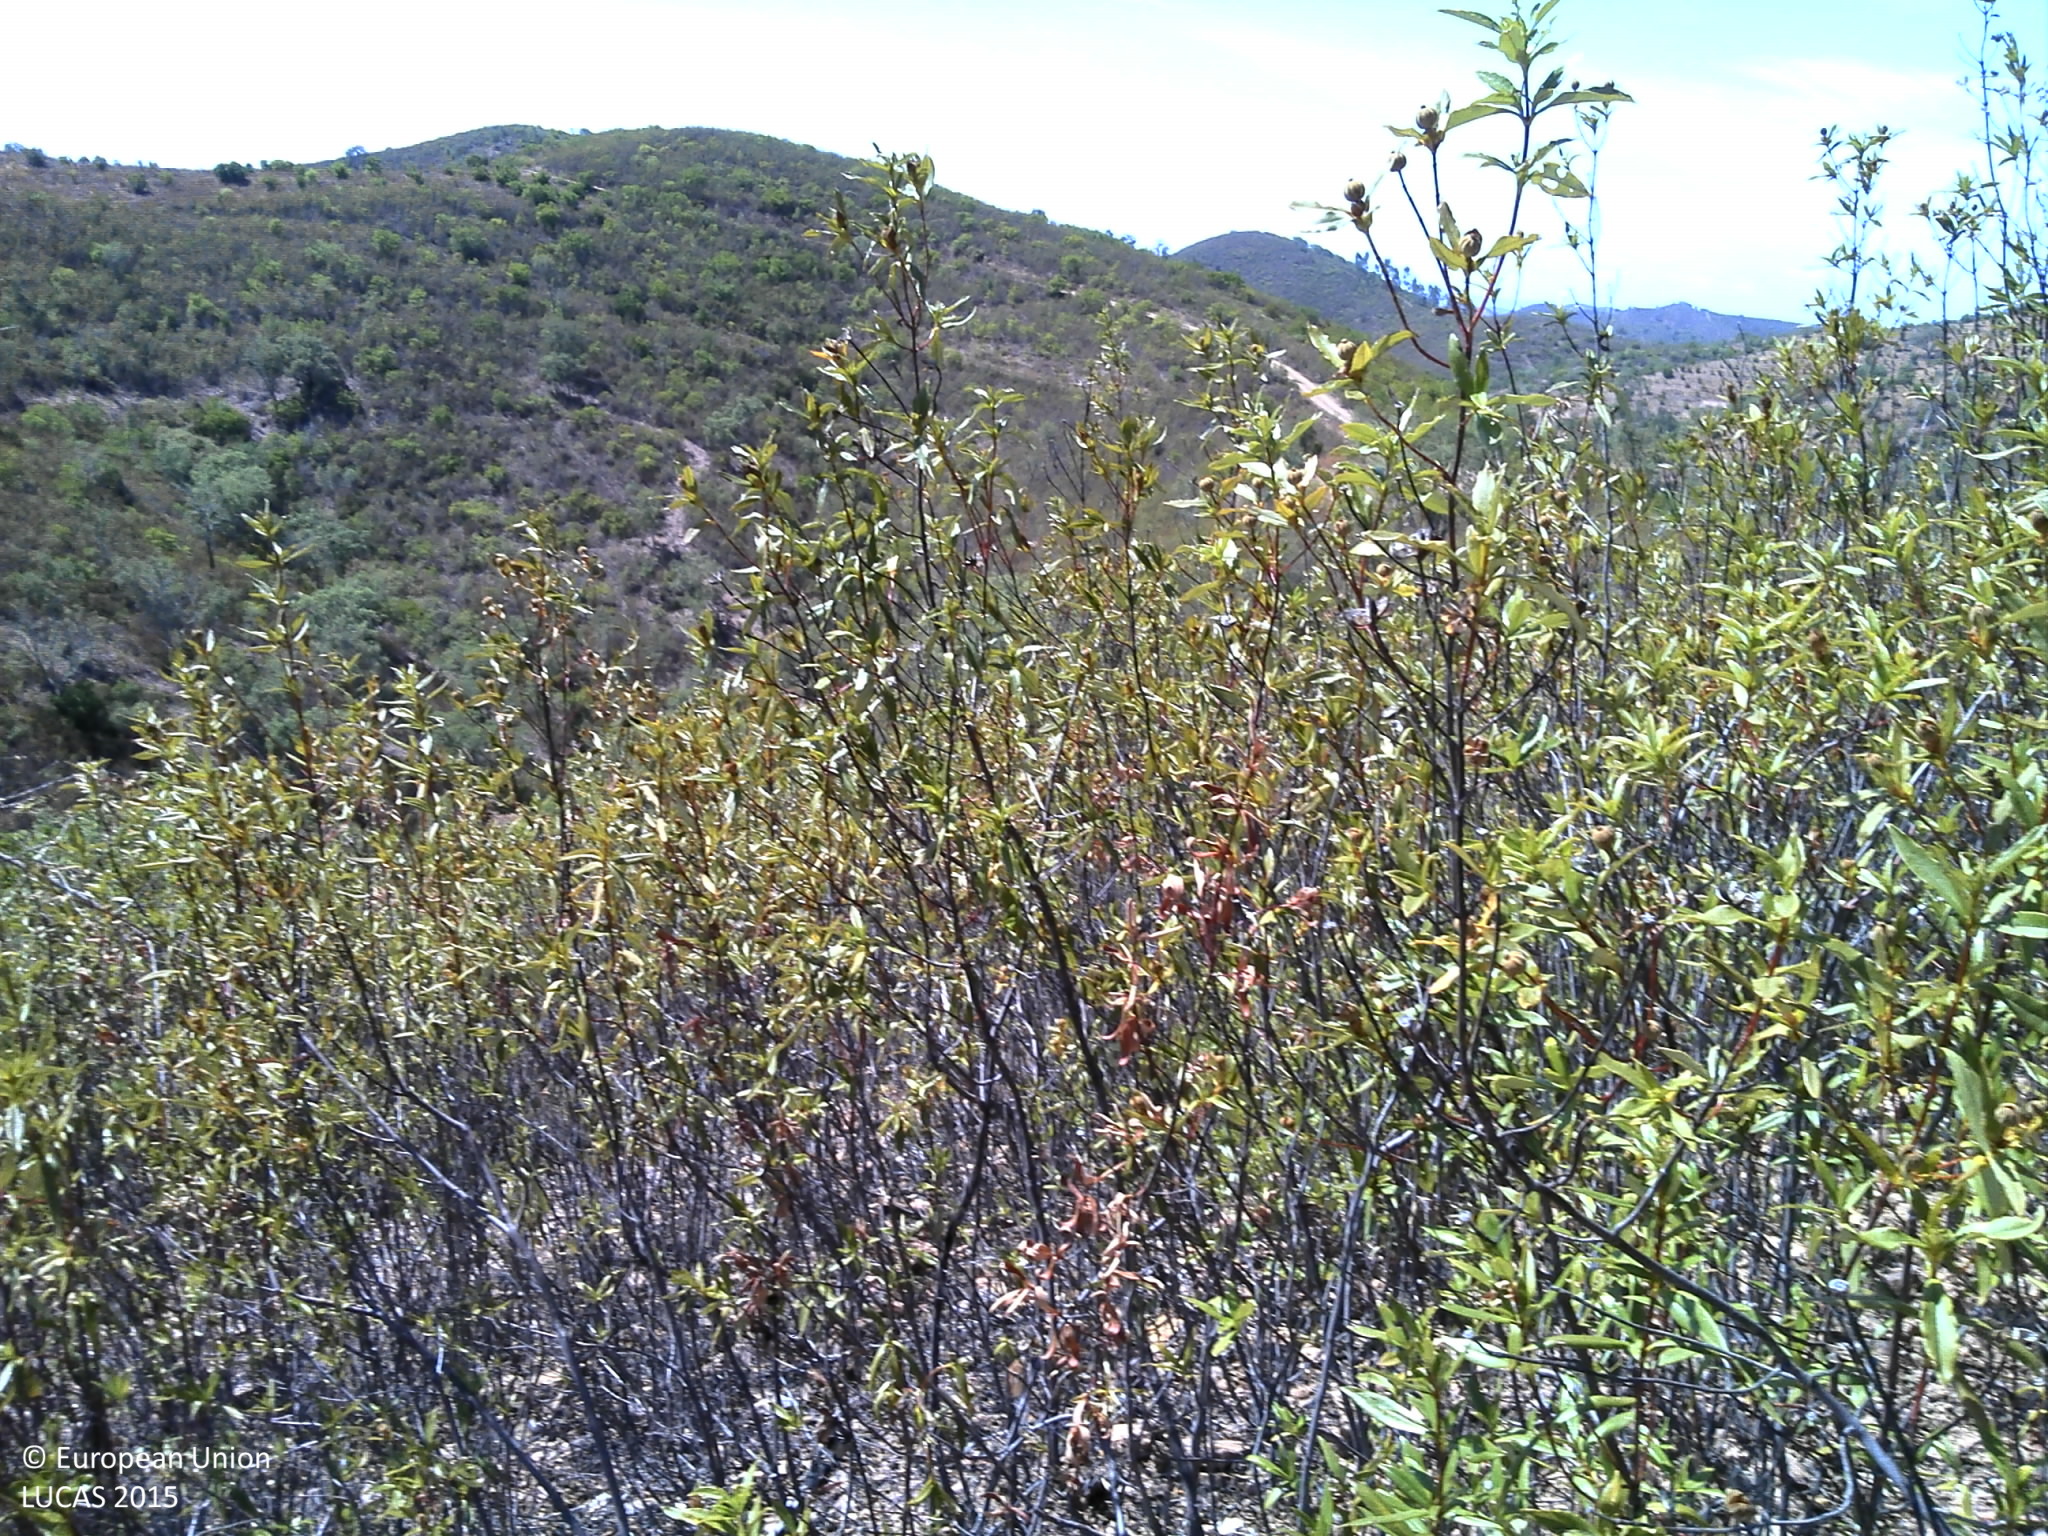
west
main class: Shrubland
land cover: Shrubland with sparse tree cover
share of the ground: 50 - 75 %
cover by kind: shrubs 60 %, unconsolidated bare surface 30 %, broadleaved forest trees 5 %, herbaceous plants 5 %
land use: Forestry
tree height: < 5 m
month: September
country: PT
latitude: 37.3883
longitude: -8.1727
